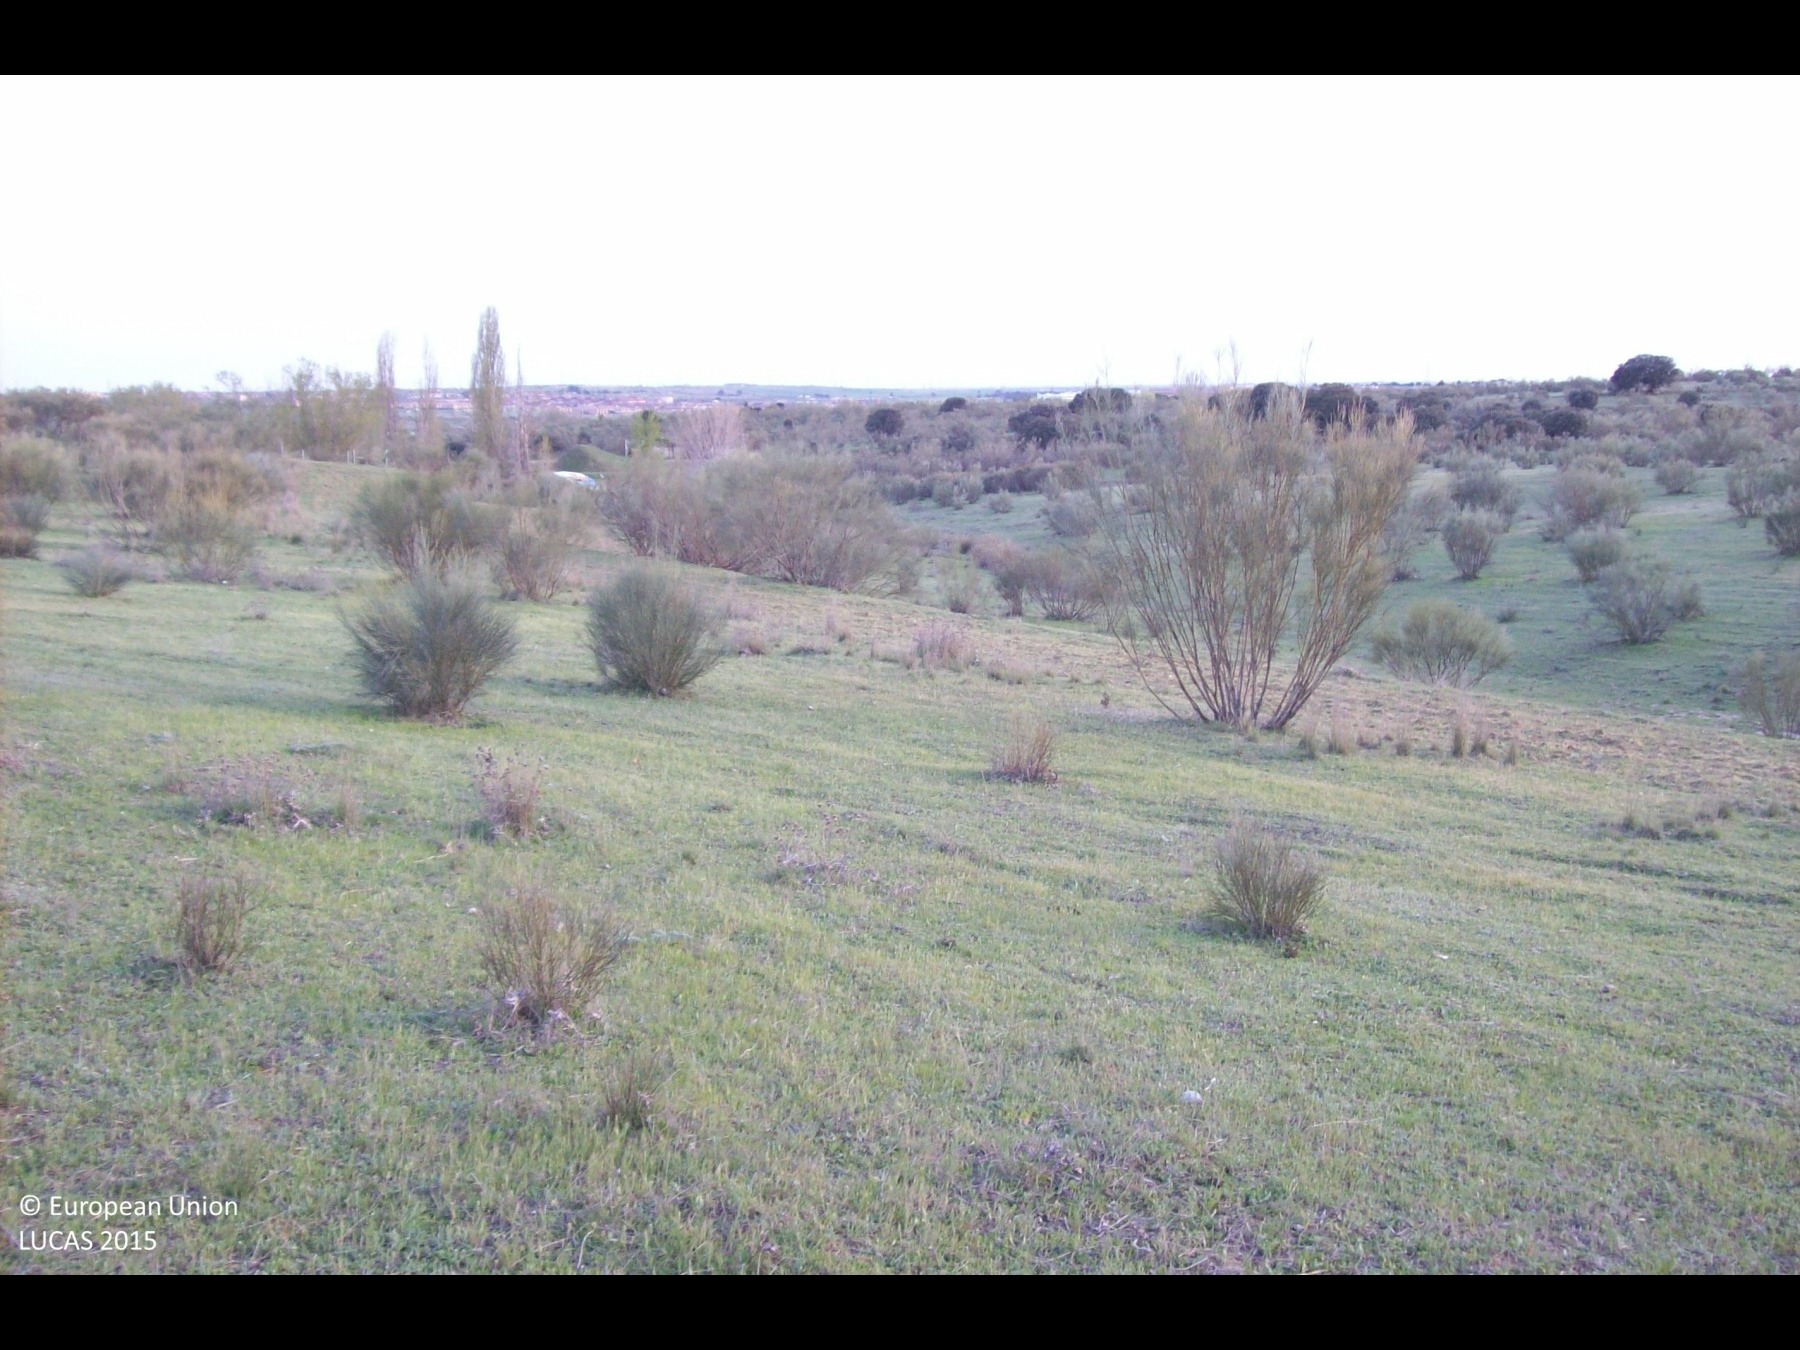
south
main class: Shrubland
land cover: Shrubland without tree cover
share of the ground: 10 - 25 %
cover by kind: herbaceous plants 90 %, shrubs 10 %
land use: Semi-natural and natural areas not in use
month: April
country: ES
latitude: 40.3896
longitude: -3.9056
